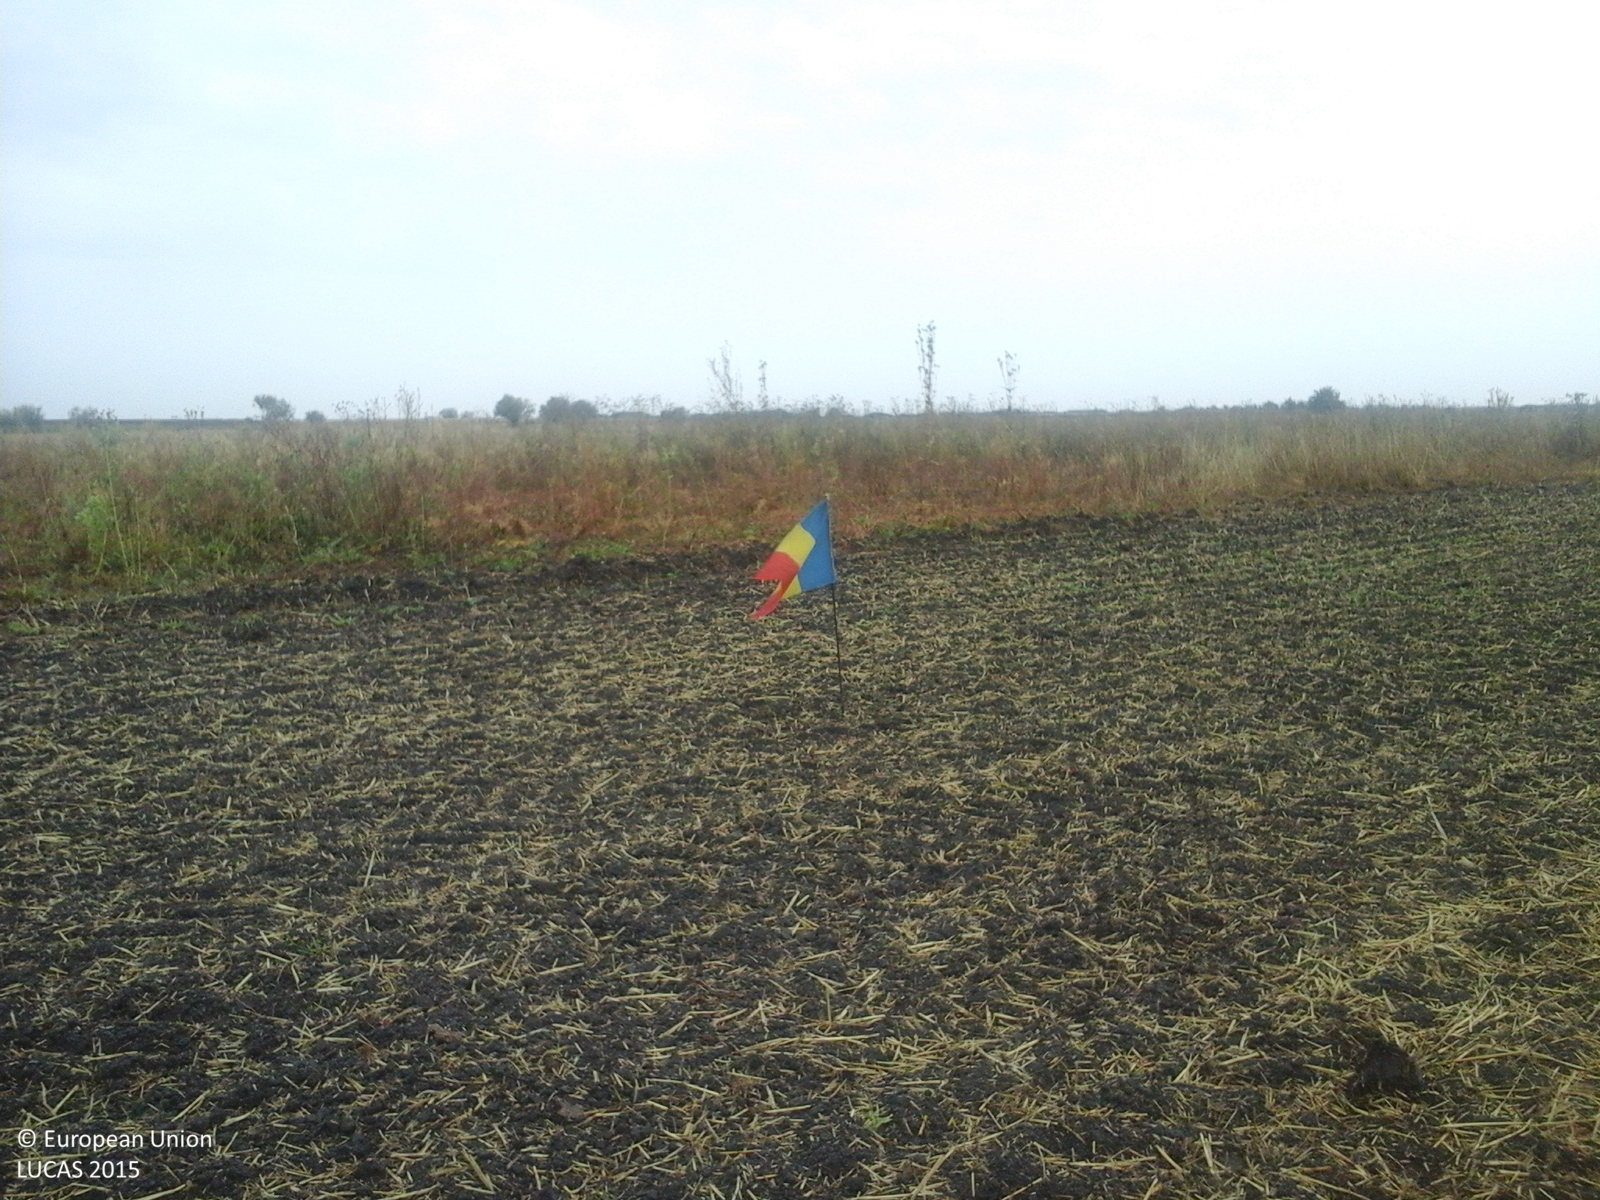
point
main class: Cropland
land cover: Common wheat
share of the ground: < 10 %
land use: Agriculture (excluding fallow land and kitchen gardens)
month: September
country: RO
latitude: 47.6091
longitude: 22.5766
